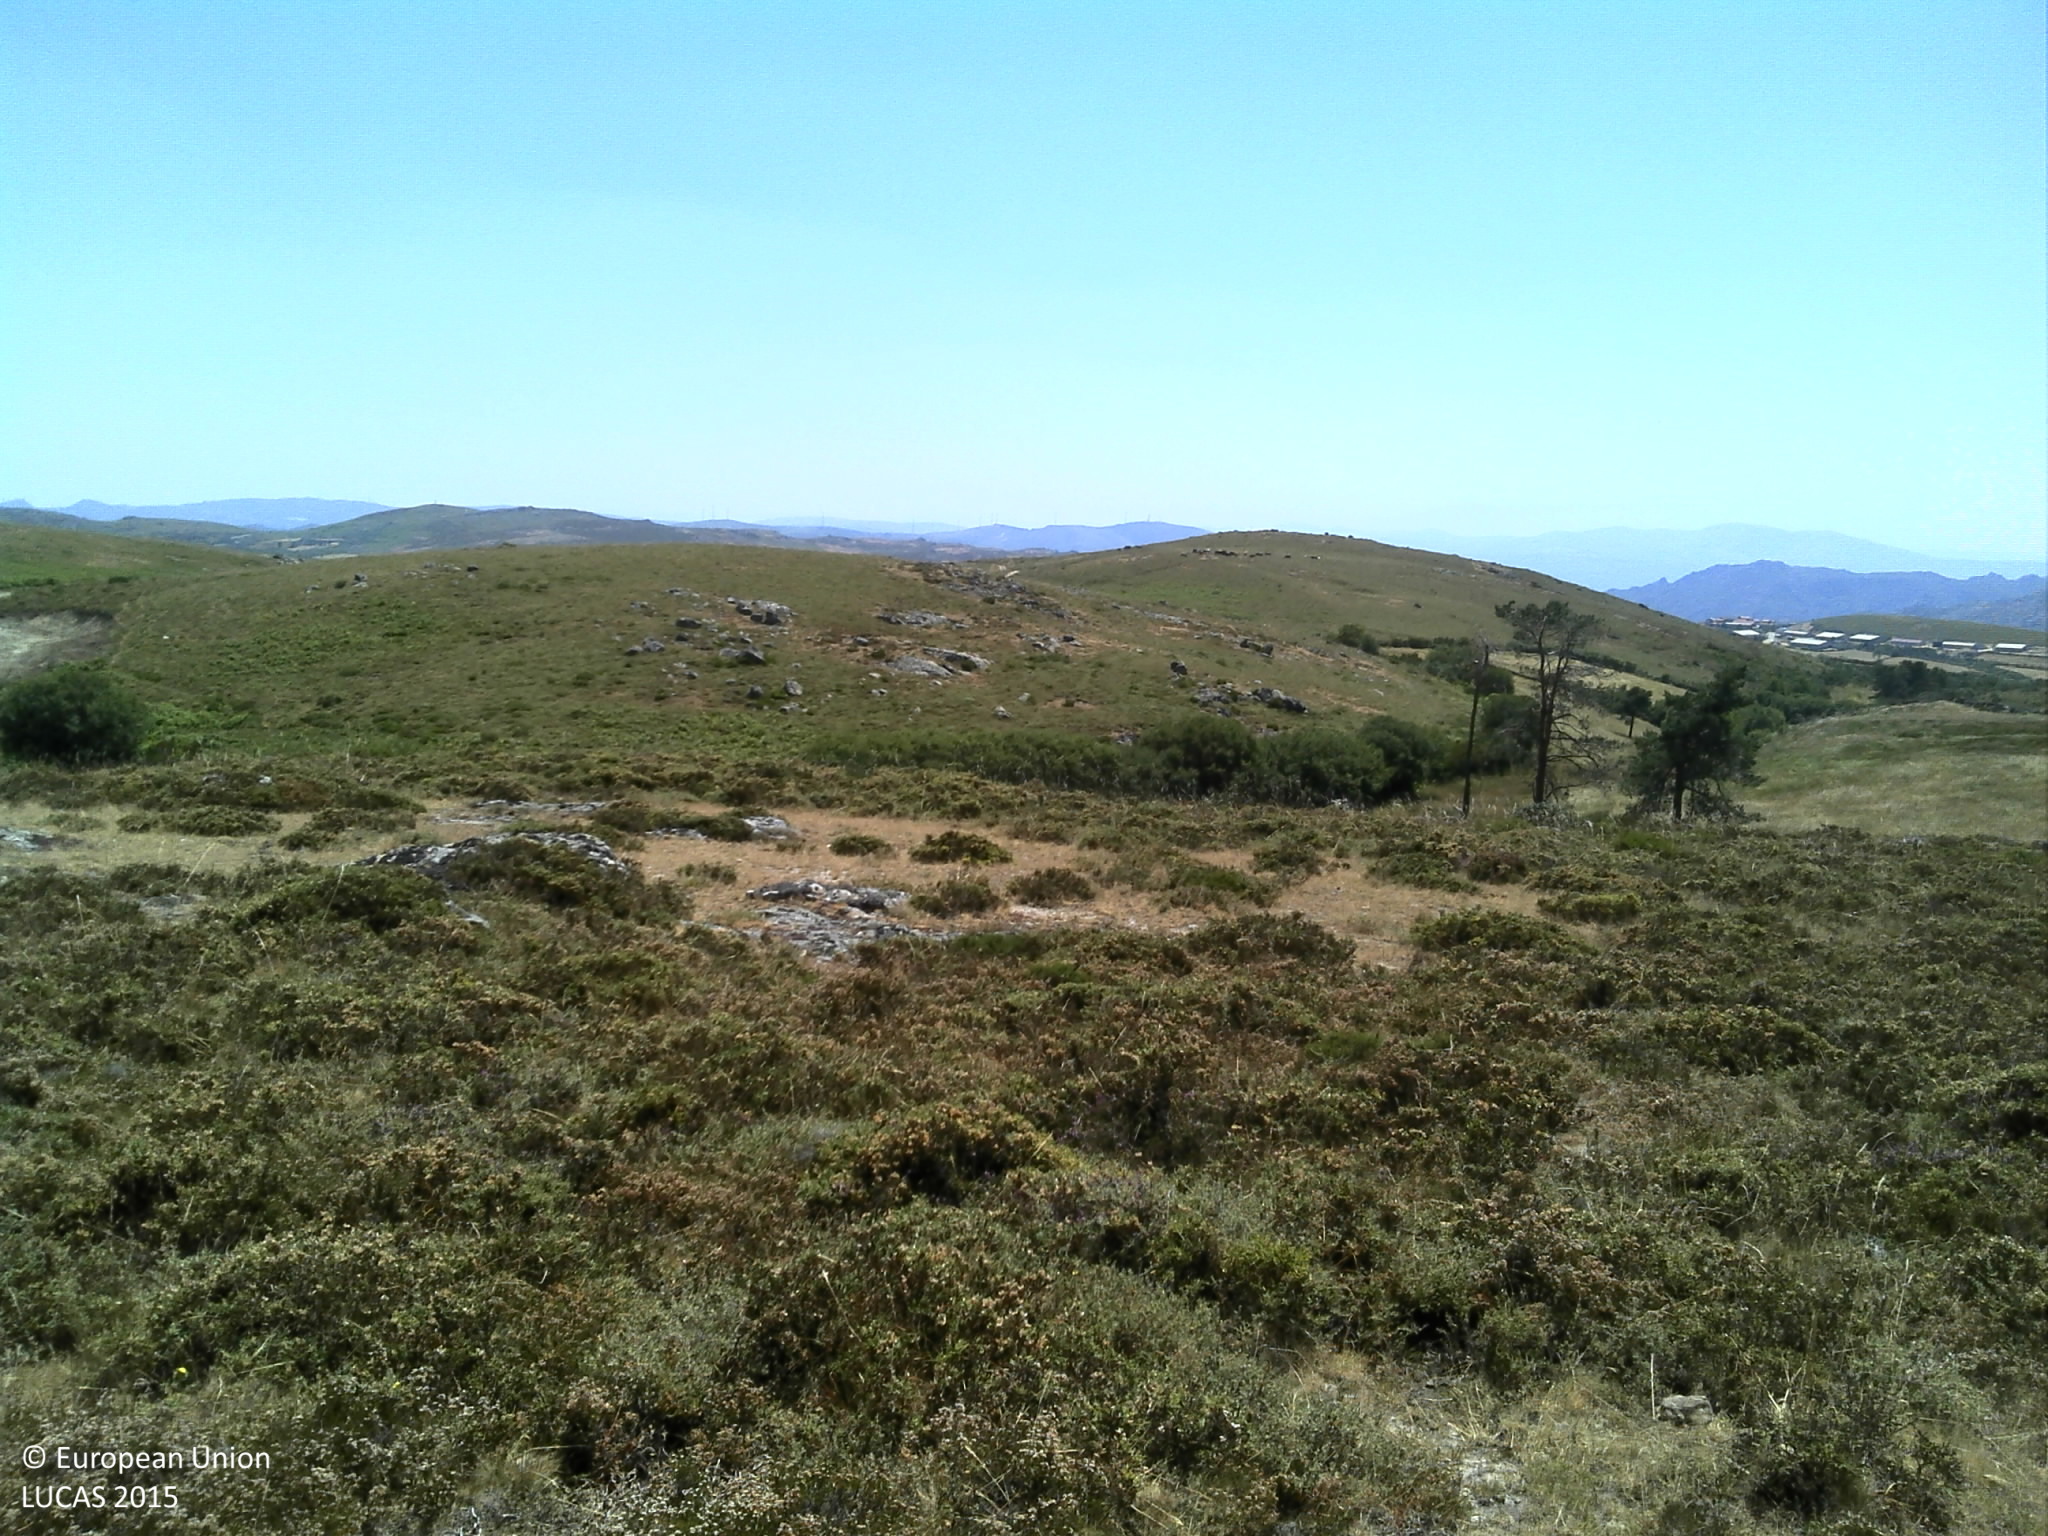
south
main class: Shrubland
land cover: Shrubland without tree cover
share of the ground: 50 - 75 %
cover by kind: shrubs 75 %, herbaceous plants 15 %, unconsolidated bare surface 10 %
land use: Agriculture (excluding fallow land and kitchen gardens)
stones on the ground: 25 - 50 %
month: July
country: PT
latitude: 41.8673
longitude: -7.9395
